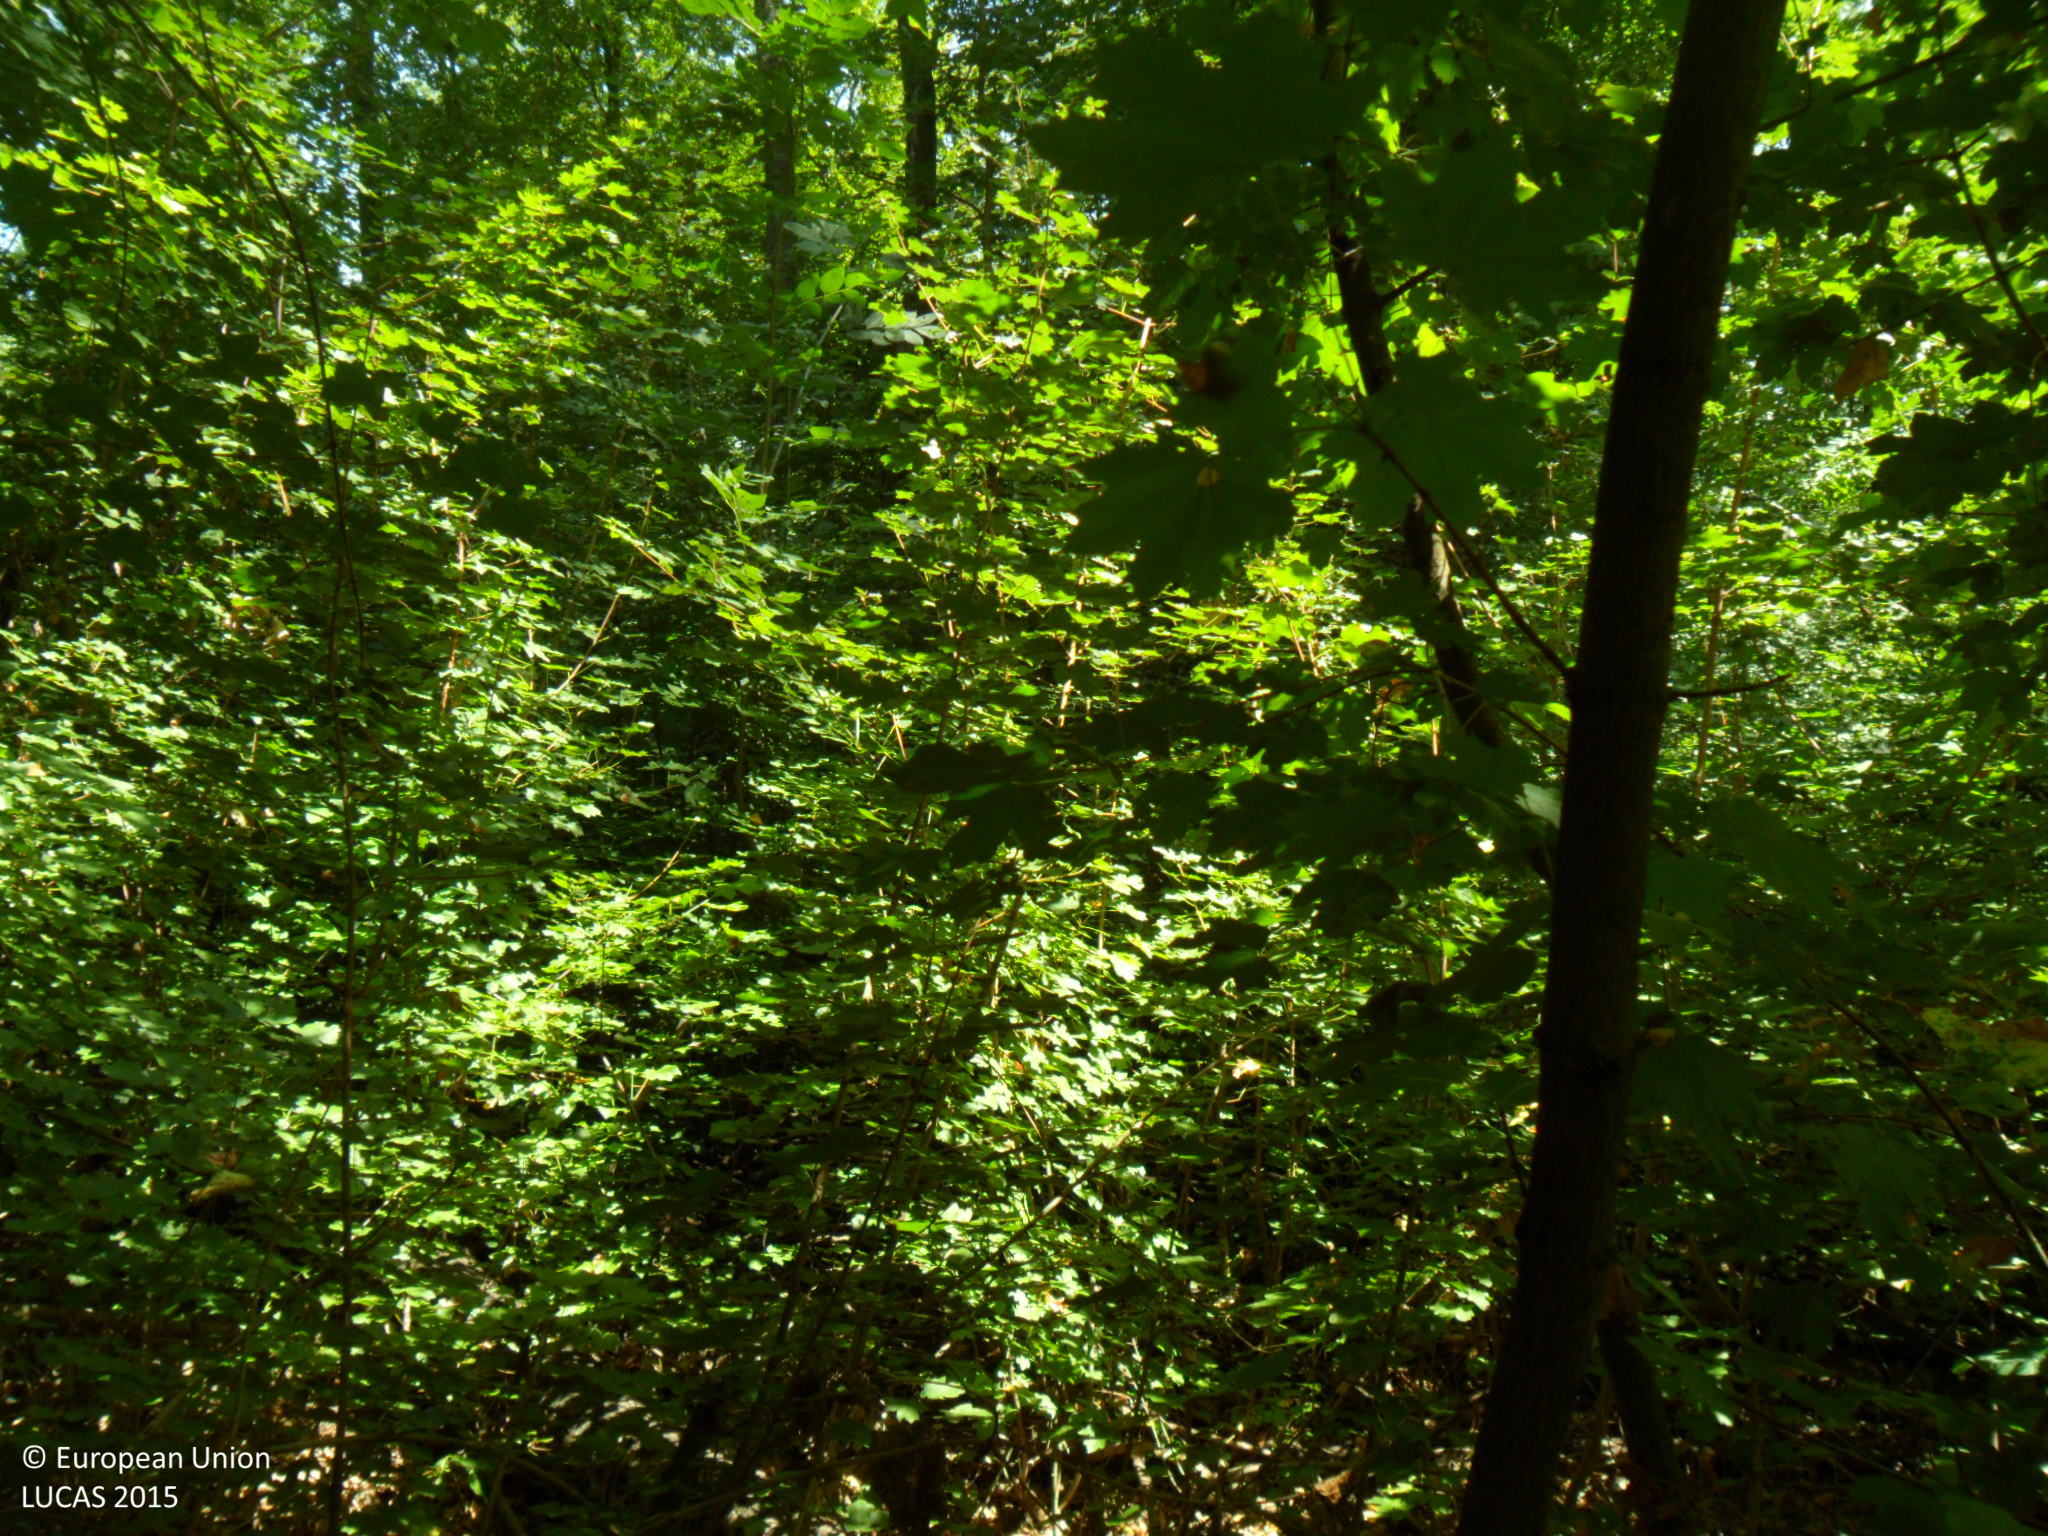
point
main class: Woodland
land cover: Broadleaved woodland
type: mesophytic deciduous forest
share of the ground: > 75 %
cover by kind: broadleaved forest trees 100 %
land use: Forestry
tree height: > 5 m
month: August
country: BG
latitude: 43.5580
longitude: 26.6859
